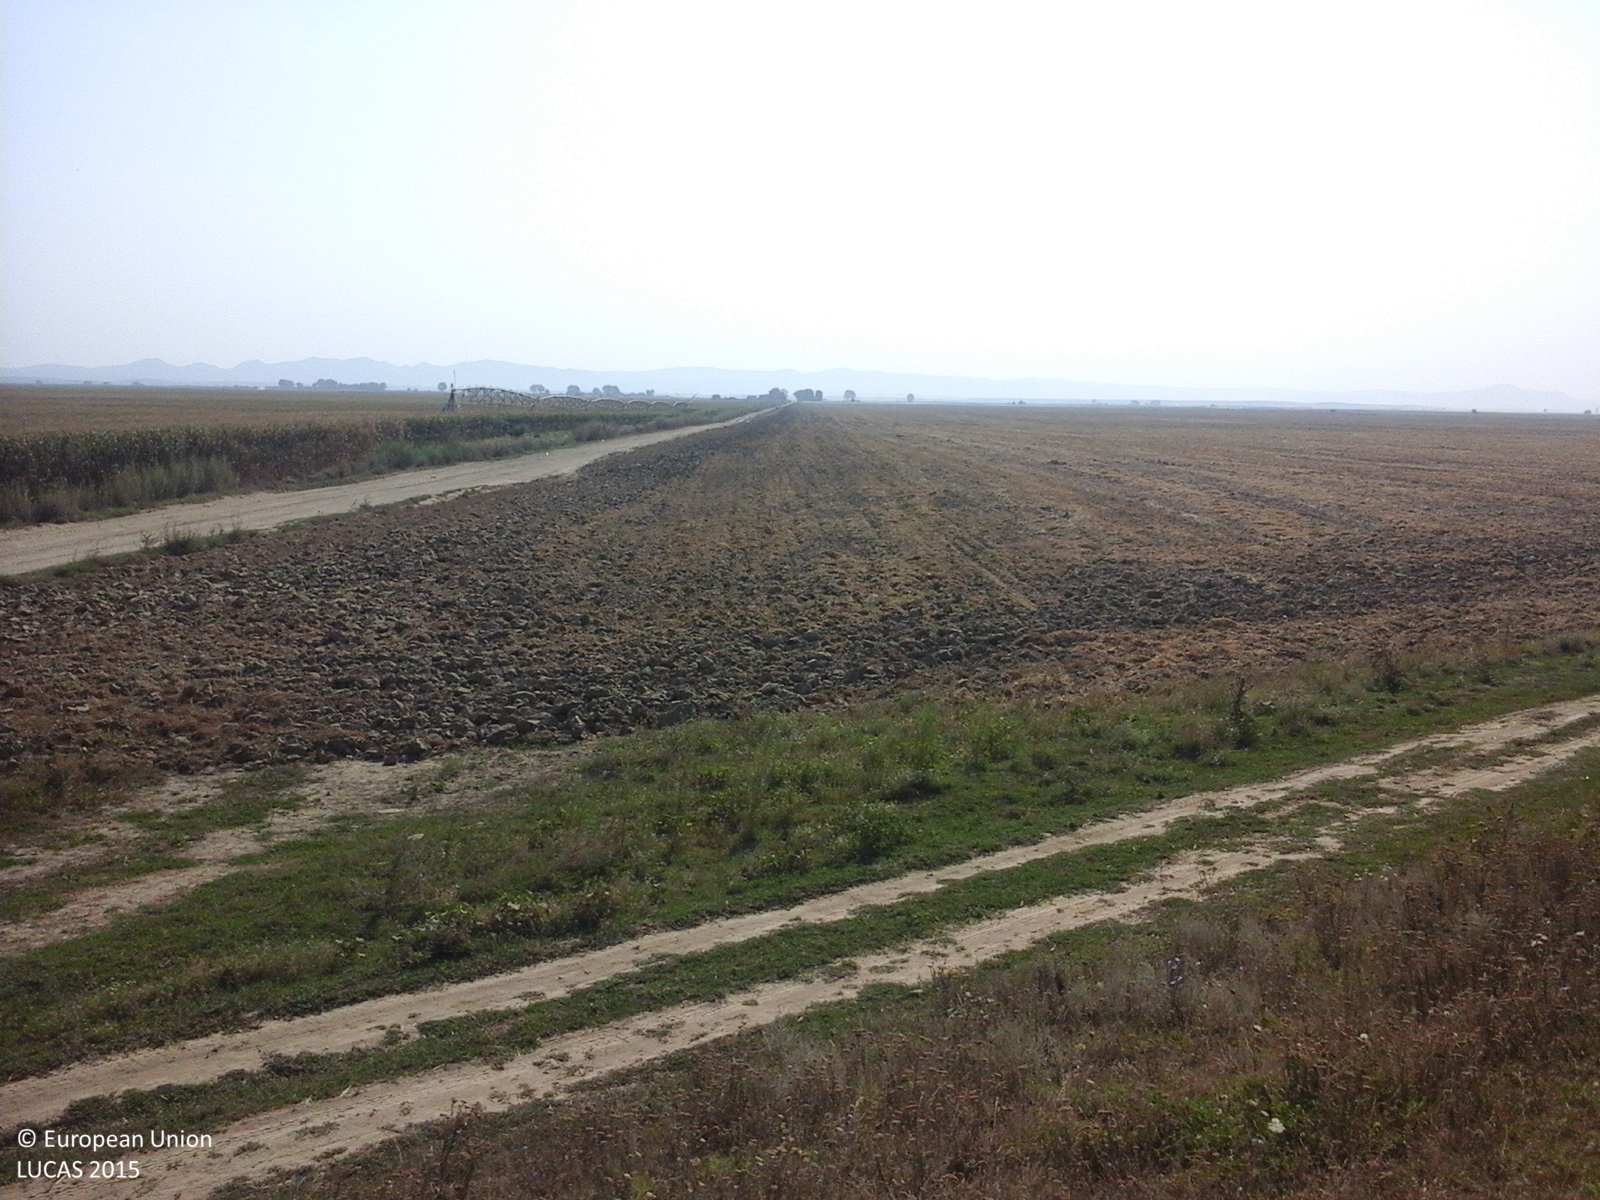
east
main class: Grassland
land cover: Spontaneously vegetated surfaces
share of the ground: > 75 %
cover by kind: herbaceous plants 100 %
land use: Agriculture (excluding fallow land and kitchen gardens)
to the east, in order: Spontaneously vegetated surfaces; Tracks; Shruby margins; Other bare soil
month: August
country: RO
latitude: 45.2169
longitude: 27.9801
